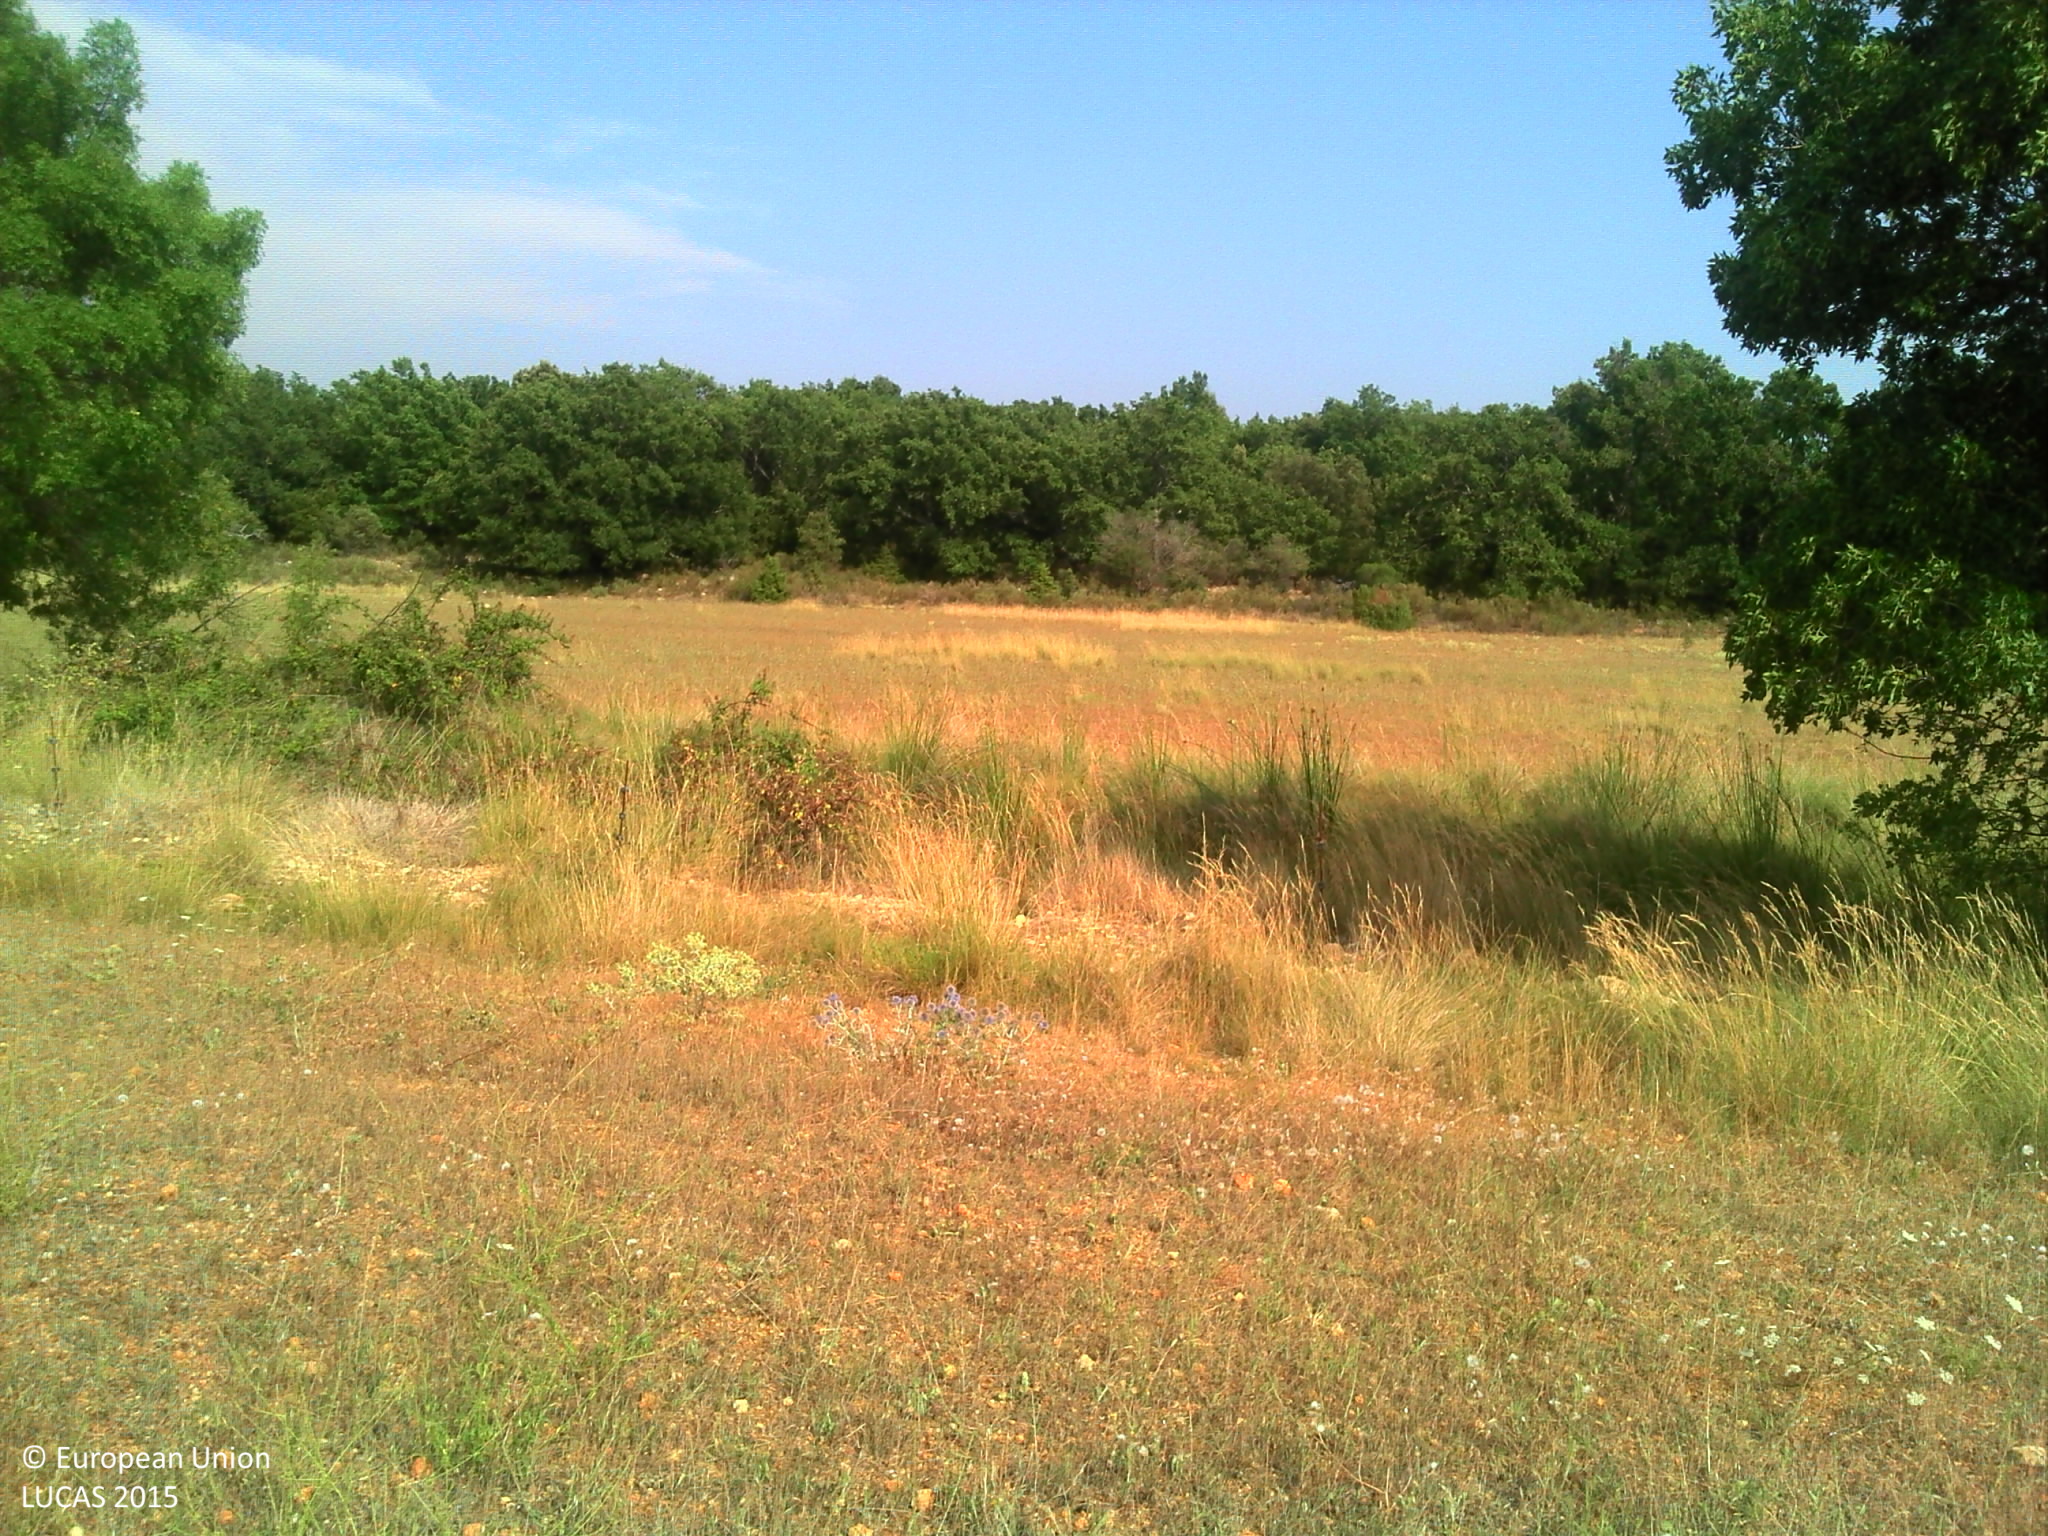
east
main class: Cropland
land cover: Temporary grasslands
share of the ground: > 75 %
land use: Agriculture (excluding fallow land and kitchen gardens)
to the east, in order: Temporary grasslands; Grass margins; Fences; Ditches and canals; Grass margins; Ditches and canals; Grassland without tree/shrub cover; Grass margins; Ditches and canals; Shrubland without tree cover; Rock outcrops; Shrubland without tree cover; Broadleaved woodland; Dry stone walls; Broadleaved woodland; Dry stone walls; Broadleaved woodland
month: August
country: FR
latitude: 43.6183
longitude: 6.3529
